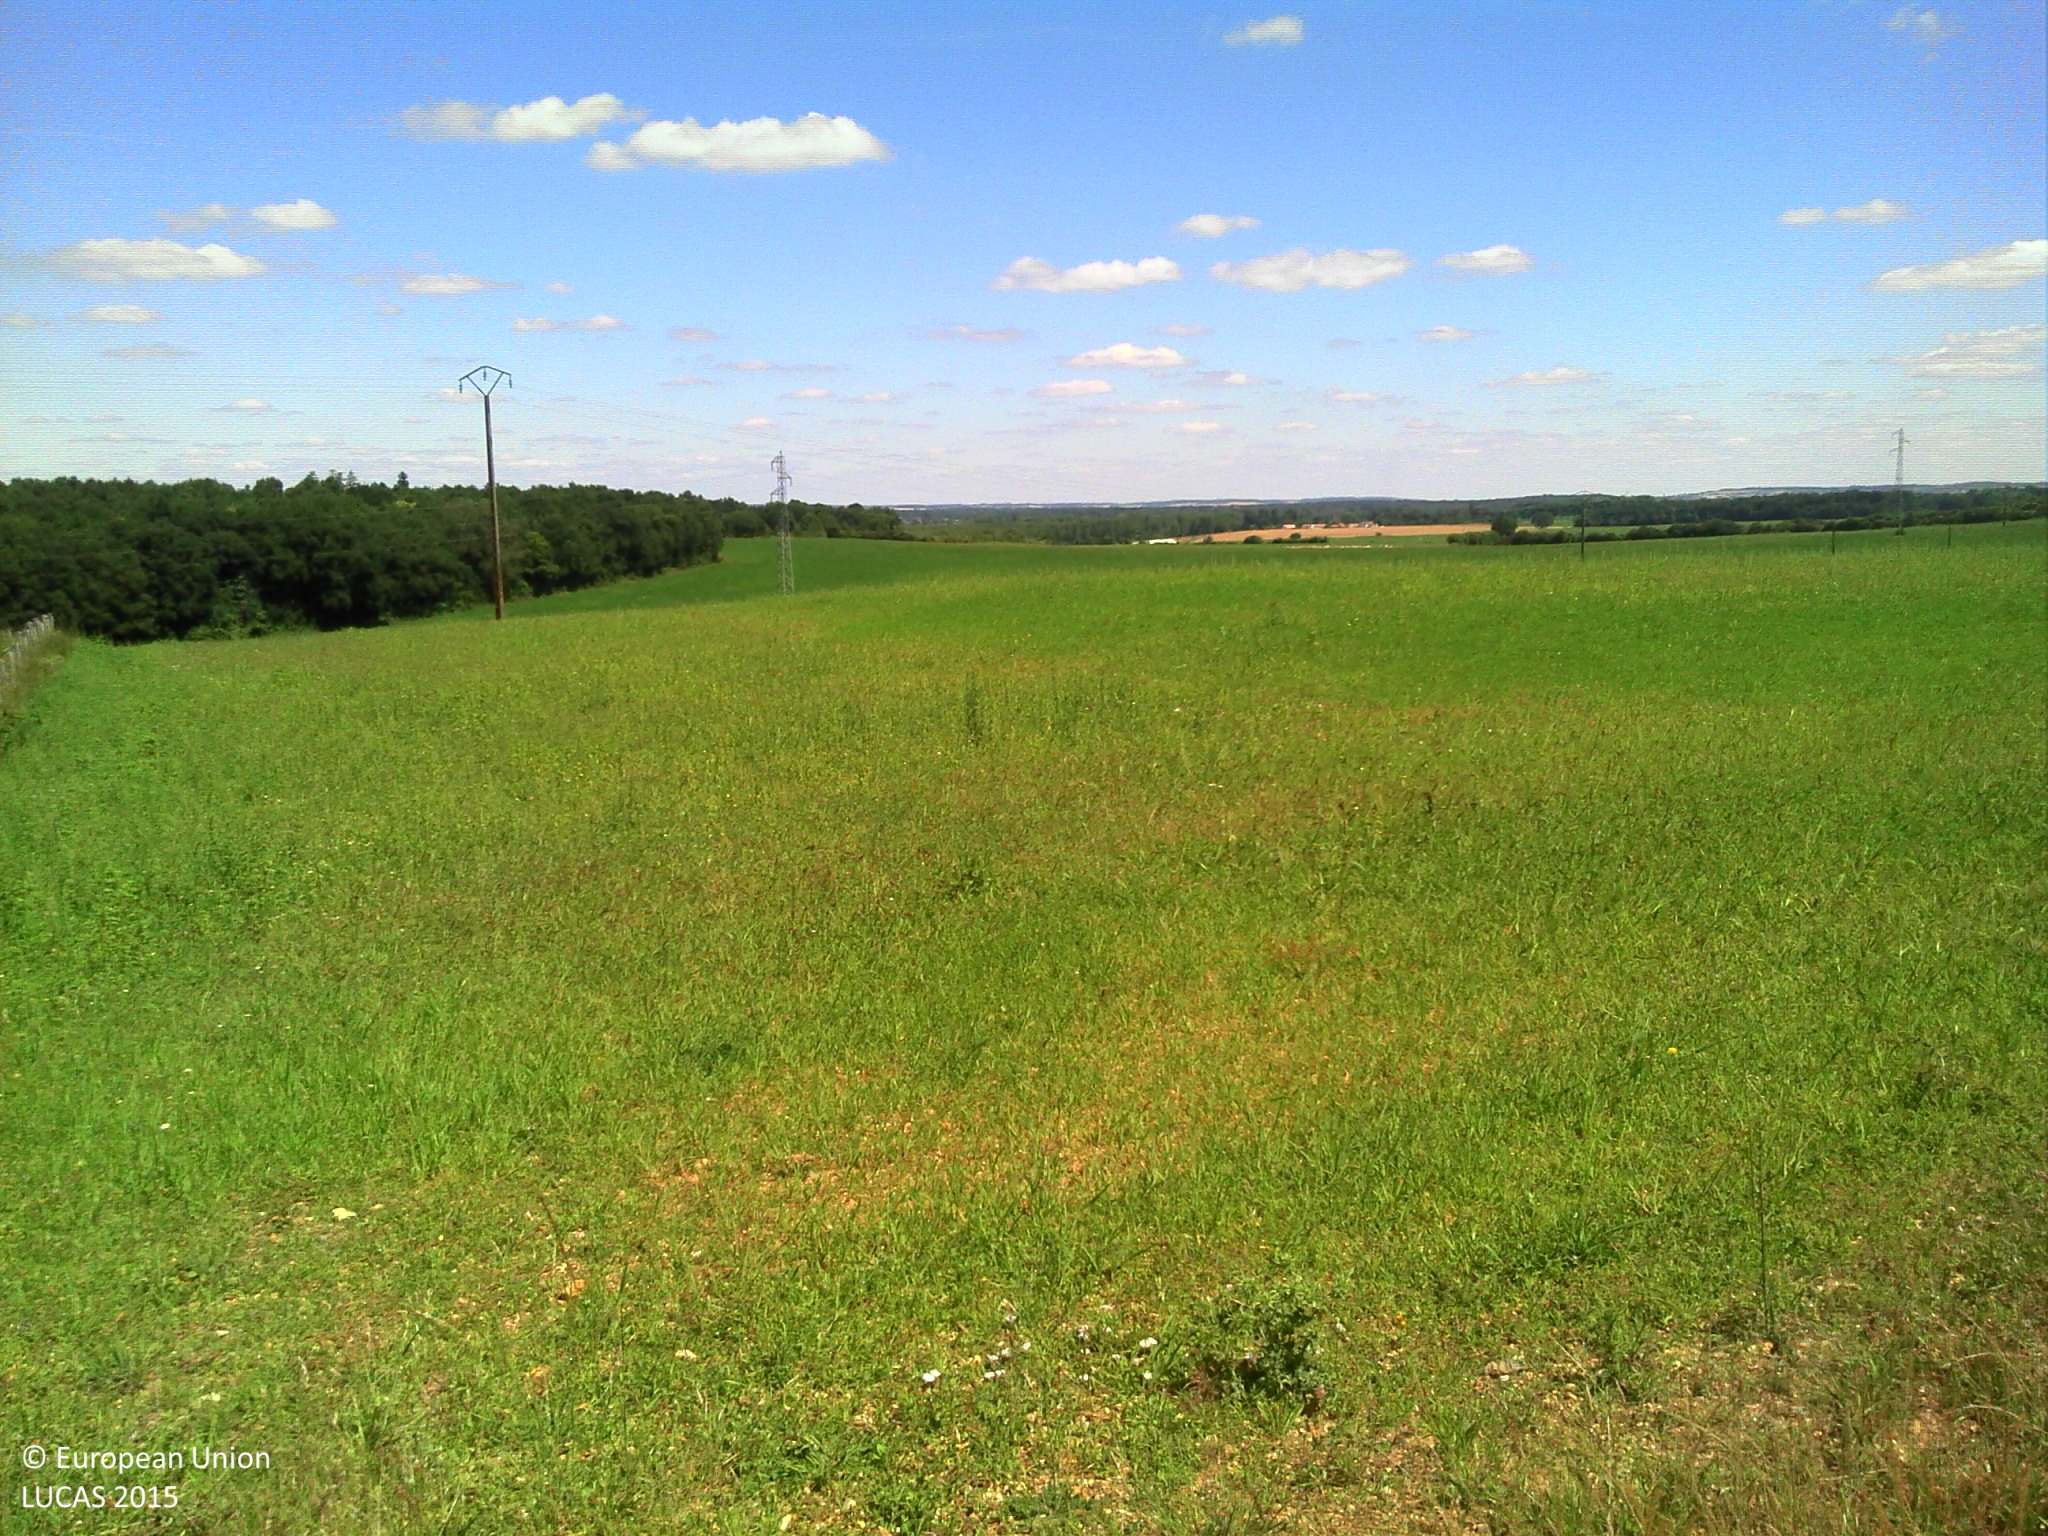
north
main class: Woodland
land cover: Broadleaved woodland
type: acidophilous oak and oak-birch forest
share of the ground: > 75 %
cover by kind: broadleaved forest trees 100 %
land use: Forestry
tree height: > 5 m
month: June
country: FR
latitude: 46.7248
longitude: 0.4955
